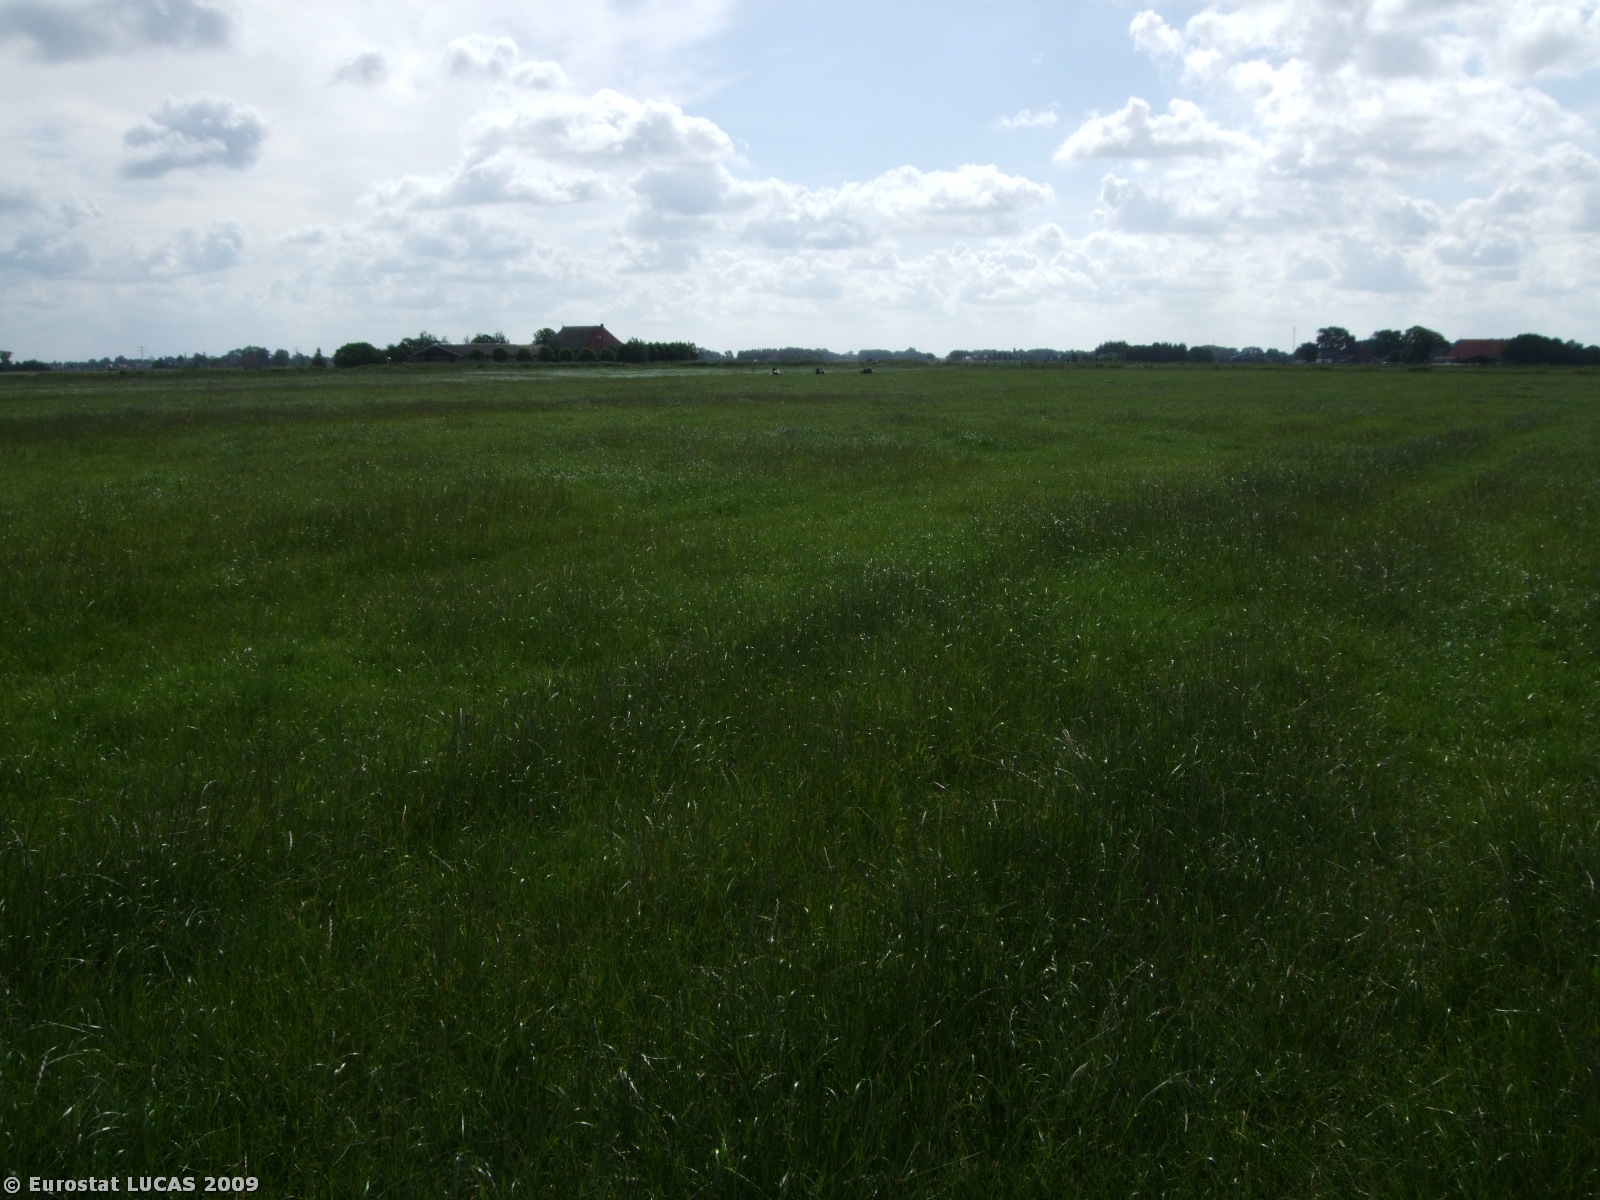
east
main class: Grassland
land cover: Grassland without tree/shrub cover
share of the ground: > 75 %
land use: Agriculture (excluding fallow land and kitchen gardens)
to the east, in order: Grassland without tree/shrub cover; Inland water bodies; Grassland without tree/shrub cover
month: June
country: NL
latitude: 53.0530
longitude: 5.6277
